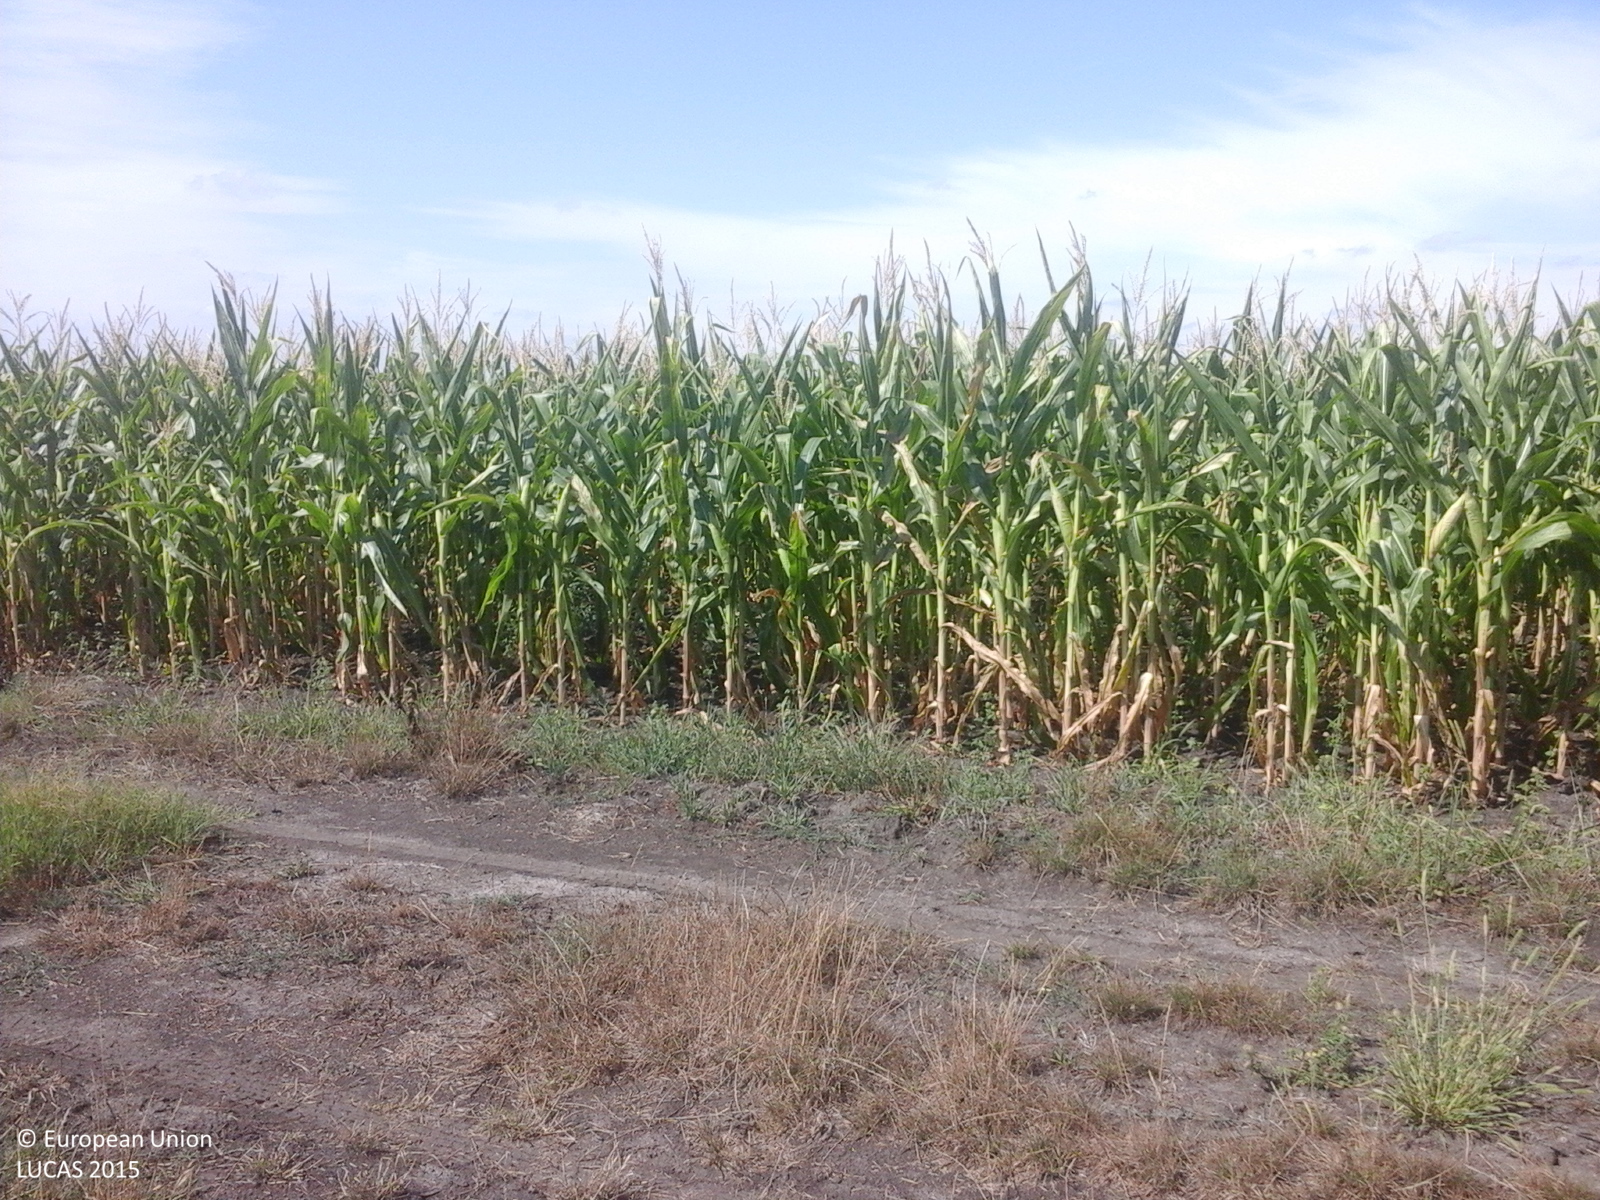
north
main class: Cropland
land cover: Maize
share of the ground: > 75 %
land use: Agriculture (excluding fallow land and kitchen gardens)
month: August
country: RO
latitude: 45.3161
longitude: 21.4473
